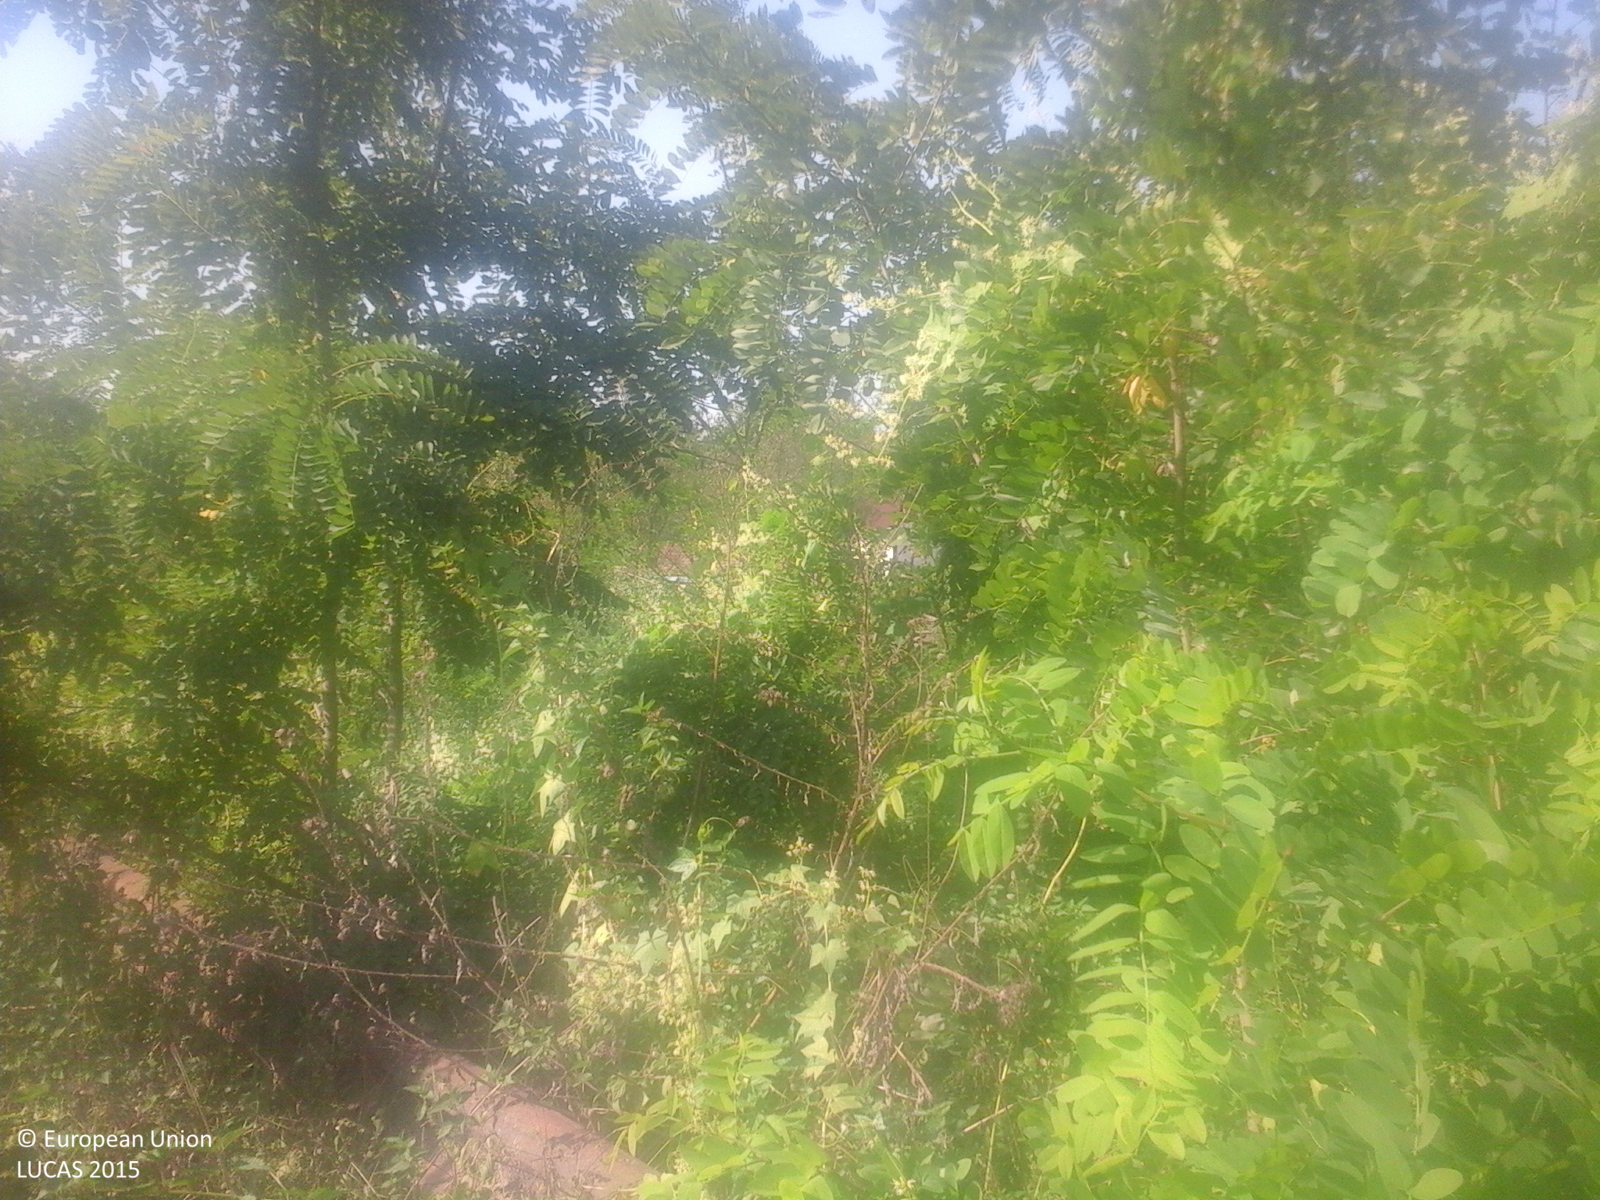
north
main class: Woodland
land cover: Broadleaved woodland
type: exotic forest
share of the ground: > 75 %
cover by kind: broadleaved forest trees 100 %
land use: Forestry
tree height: > 5 m
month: September
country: RO
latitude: 46.9371
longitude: 23.7493
